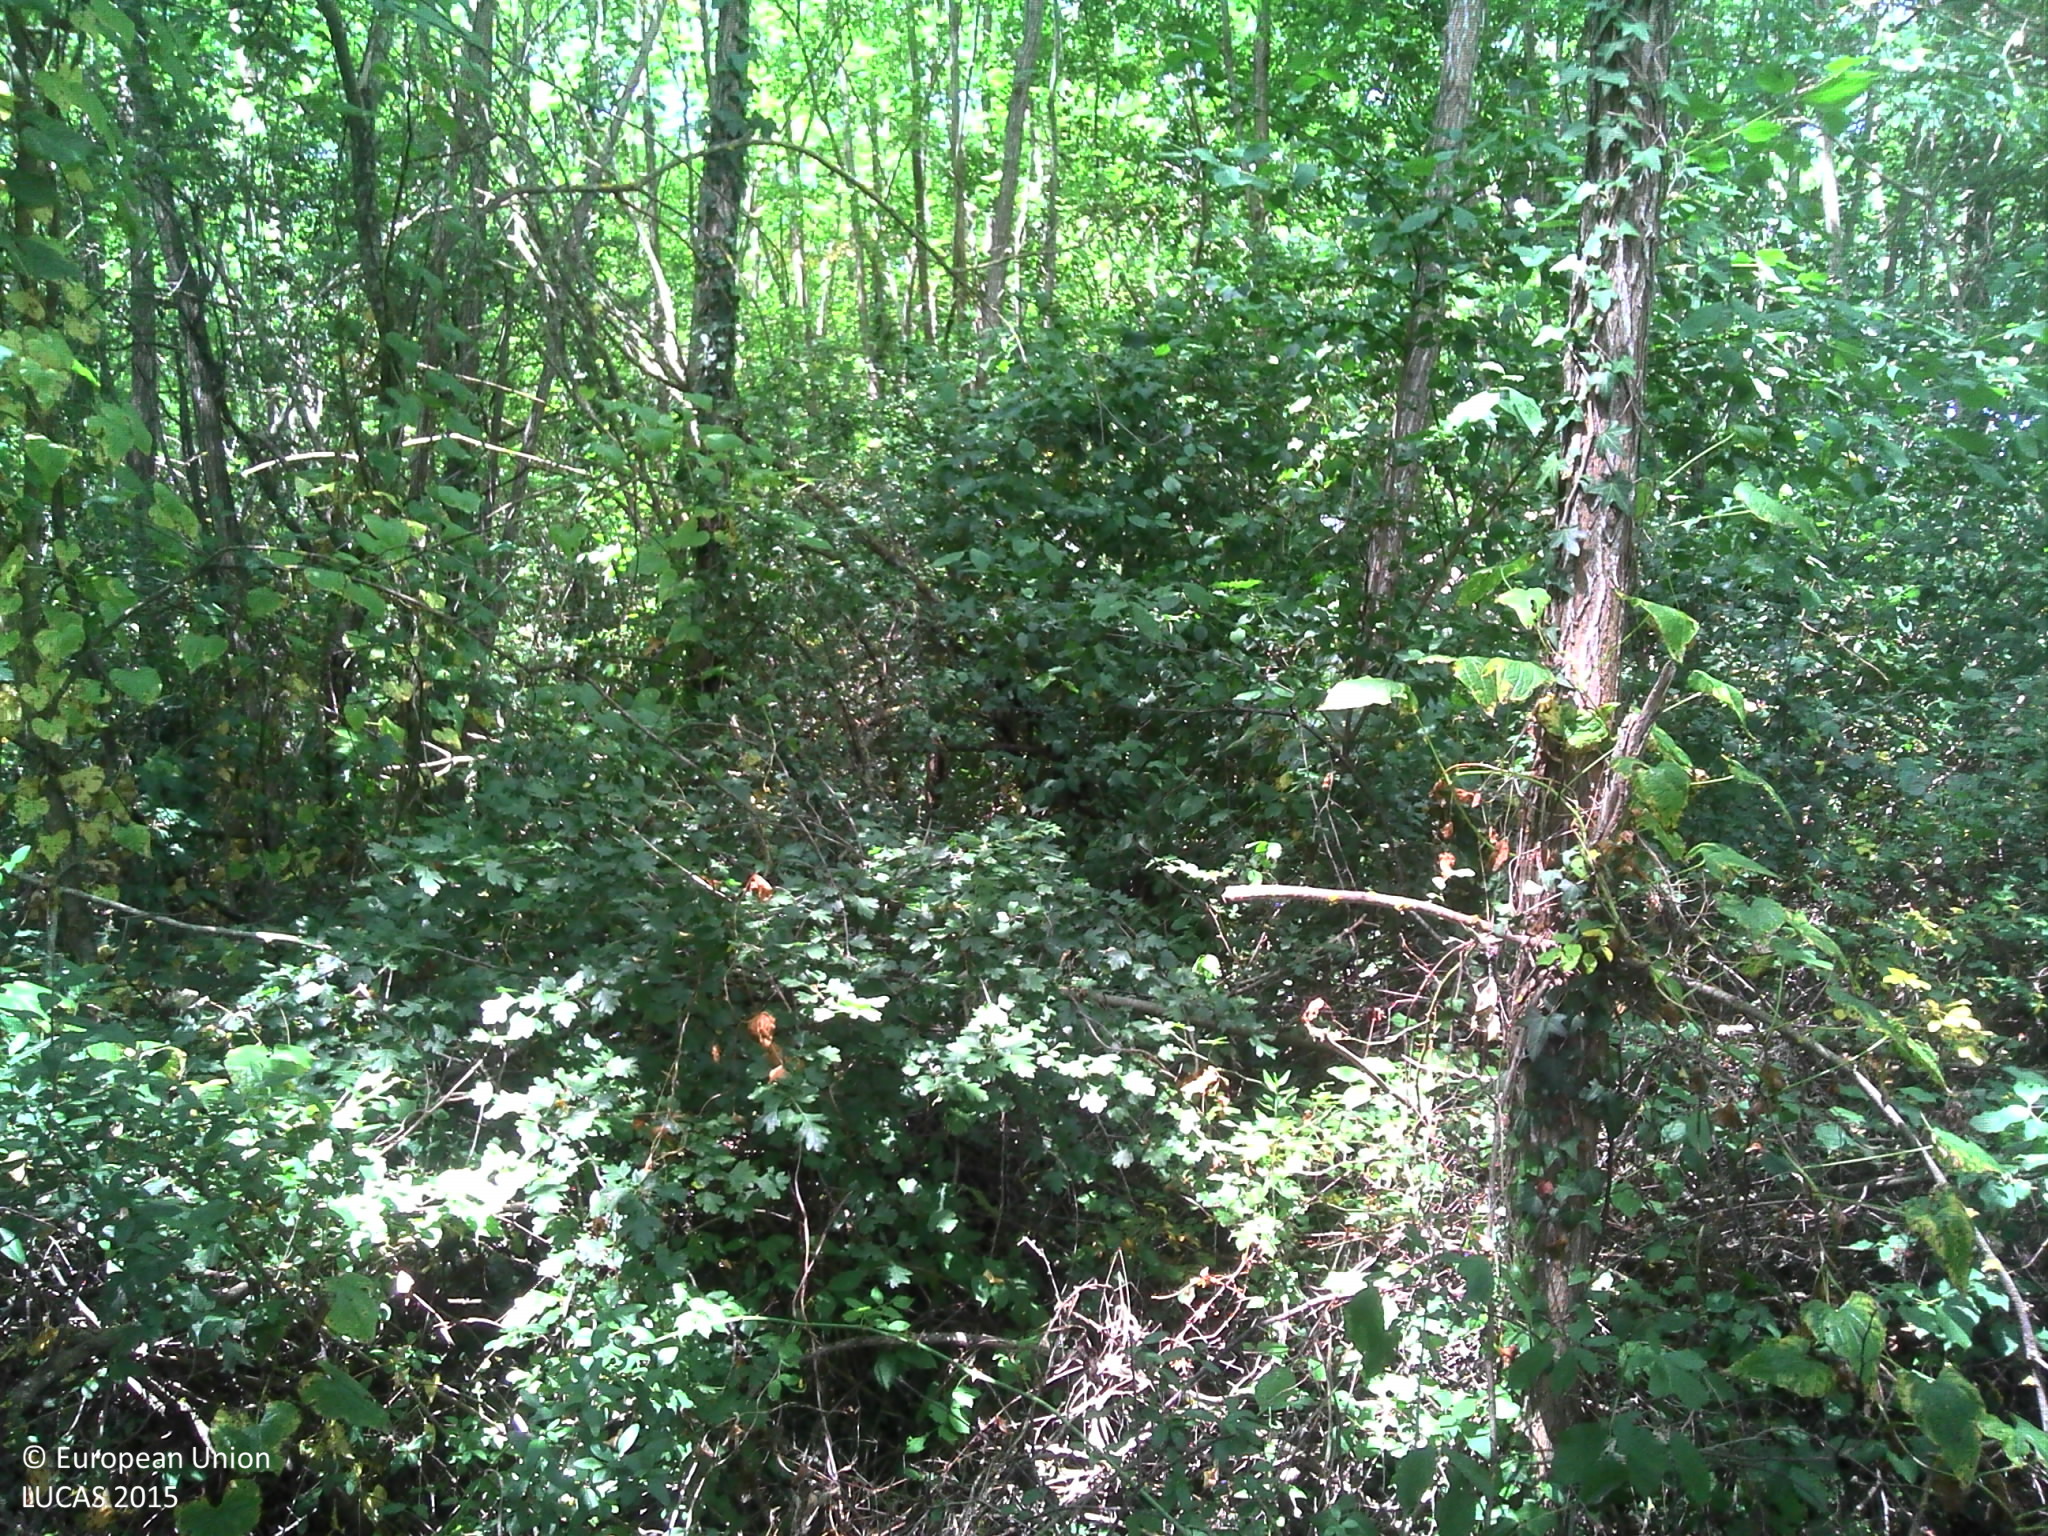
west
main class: Woodland
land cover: Broadleaved woodland
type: acidophilous oak and oak-birch forest
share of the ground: > 75 %
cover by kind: broadleaved forest trees 80 %, shrubs 10 %, herbaceous plants 10 %
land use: Forestry
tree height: > 5 m
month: July
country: FR
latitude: 43.1859
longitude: 1.0830
